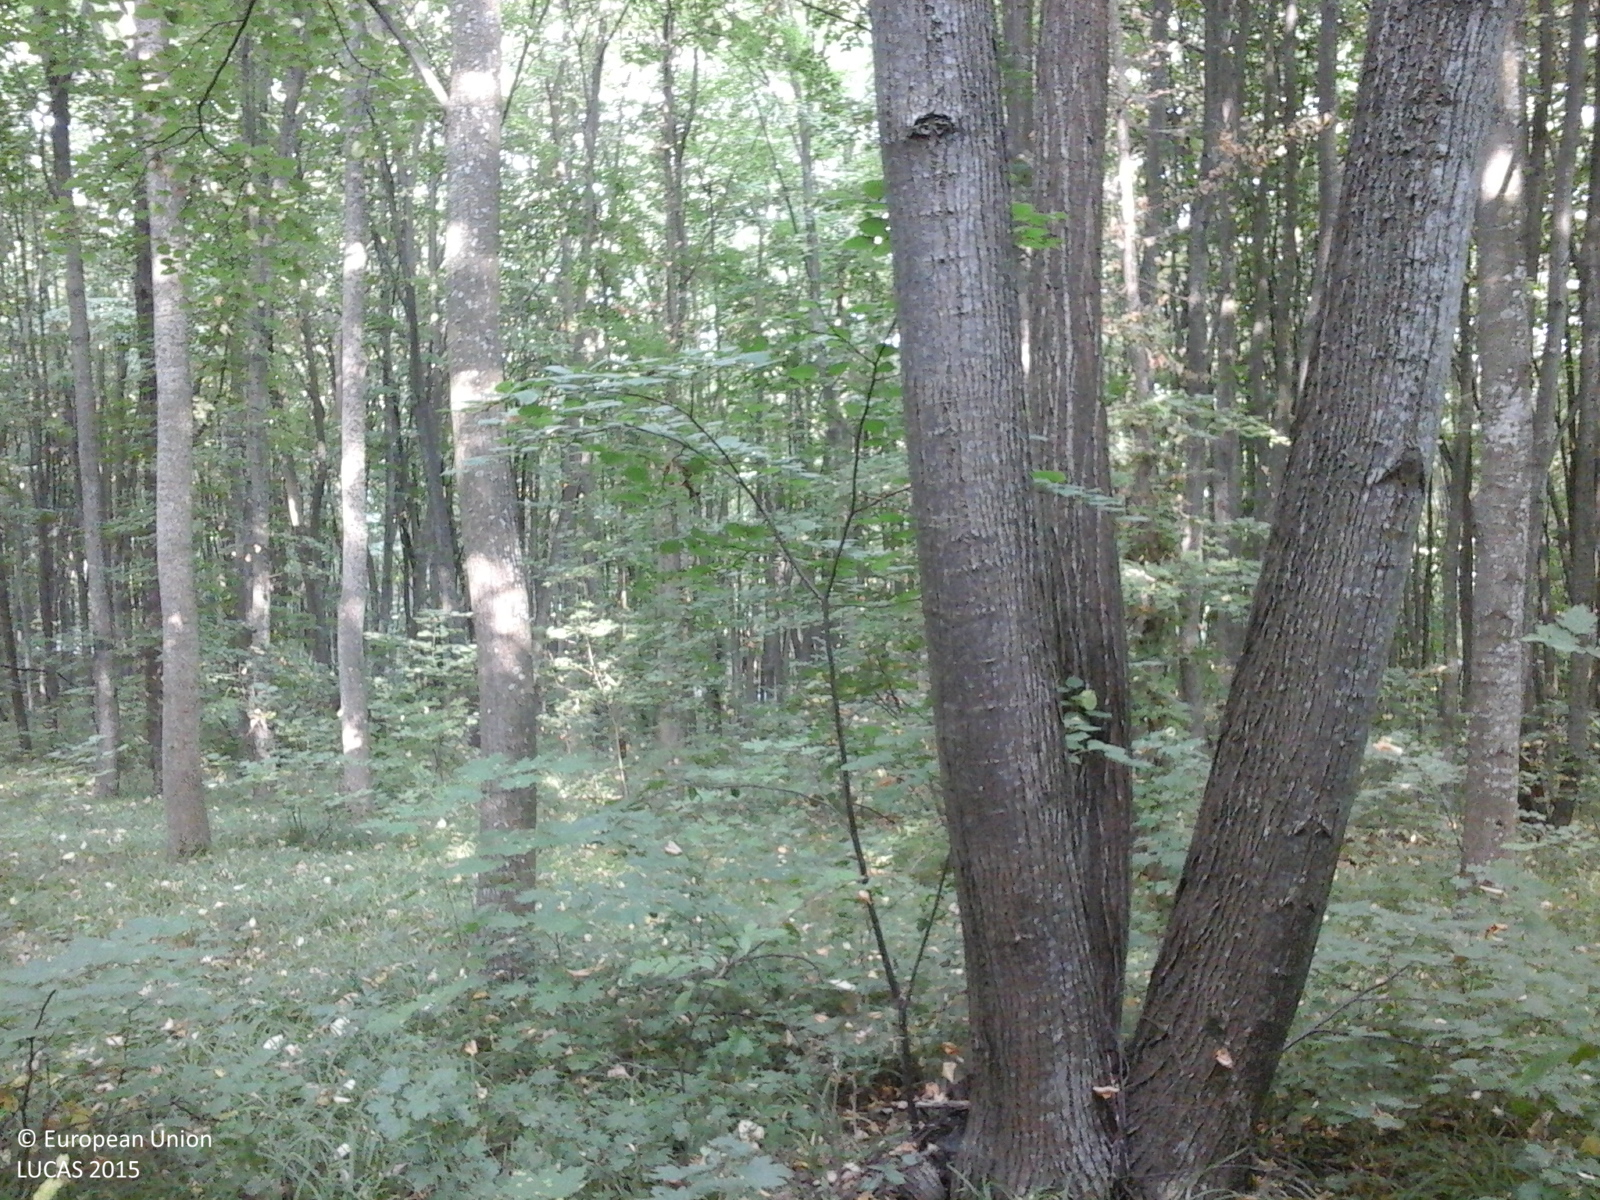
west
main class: Woodland
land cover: Broadleaved woodland
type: mesophytic deciduous forest
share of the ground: > 75 %
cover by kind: broadleaved forest trees 100 %
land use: Forestry
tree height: > 5 m
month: July
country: RO
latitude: 45.2124
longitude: 28.3206
